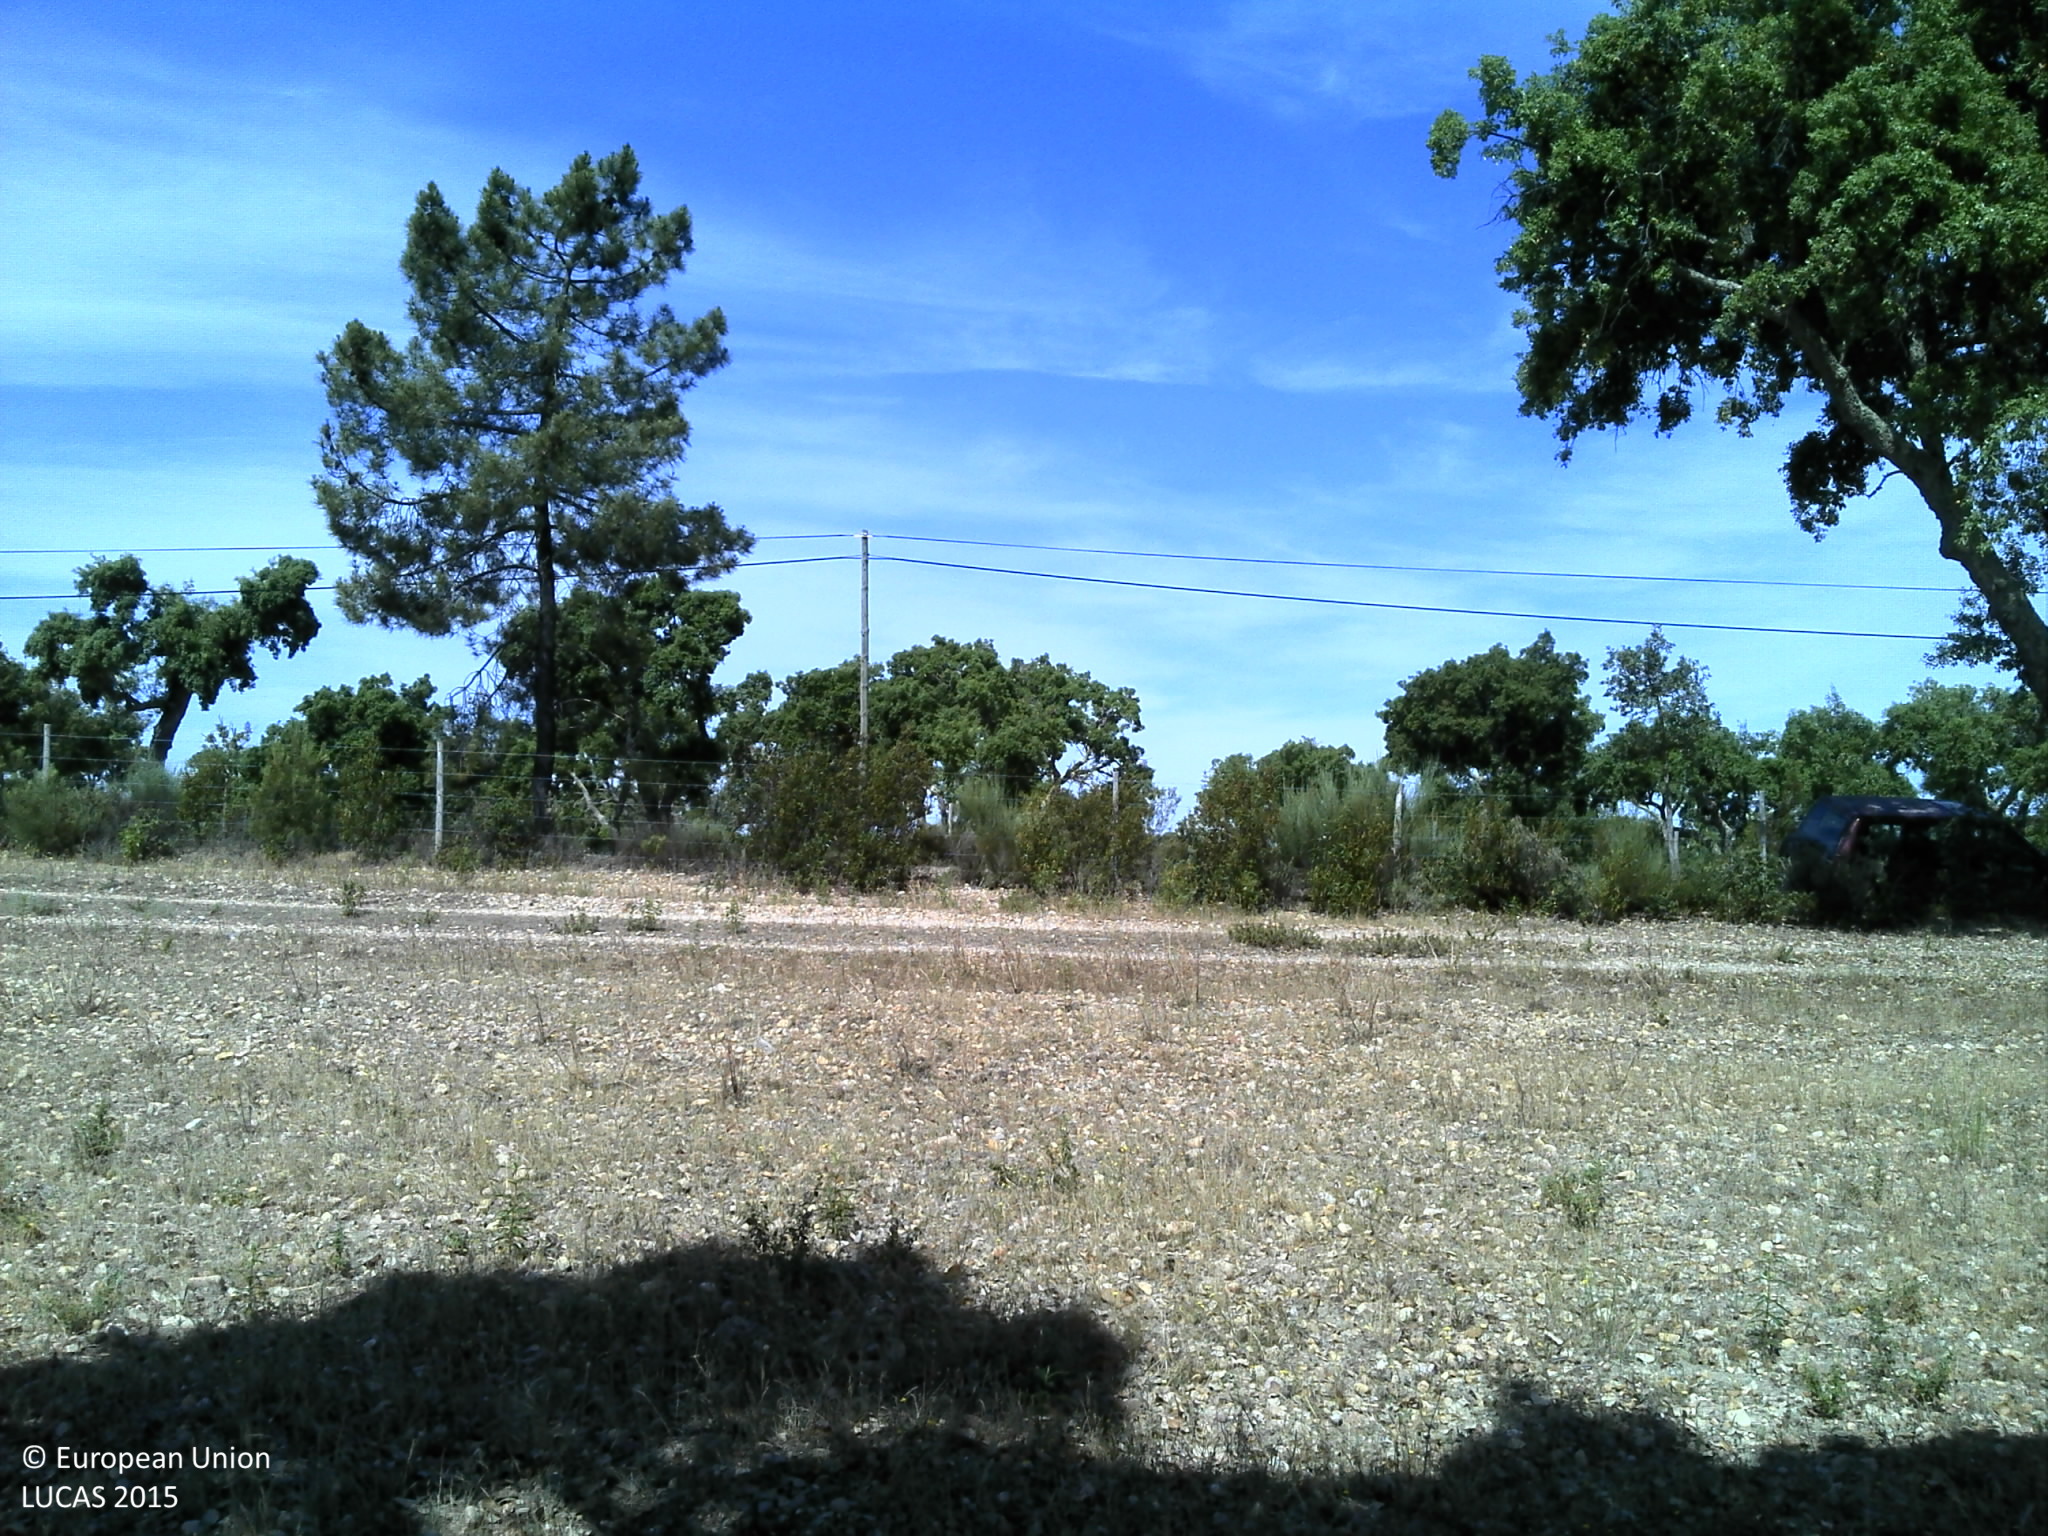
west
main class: Woodland
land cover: Broadleaved woodland
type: broadleaved evergreen forest
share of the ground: 25 - 50 %
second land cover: Grassland without tree/shrub cover
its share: 10 - 25 %
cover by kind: broadleaved forest trees 40 %, unconsolidated bare surface 30 %, herbaceous plants 25 %, shrubs 5 %
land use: Forestry
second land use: Agriculture (excluding fallow land and kitchen gardens)
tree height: > 5 m
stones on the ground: < 10 %
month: May
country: PT
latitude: 39.2861
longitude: -7.9188
